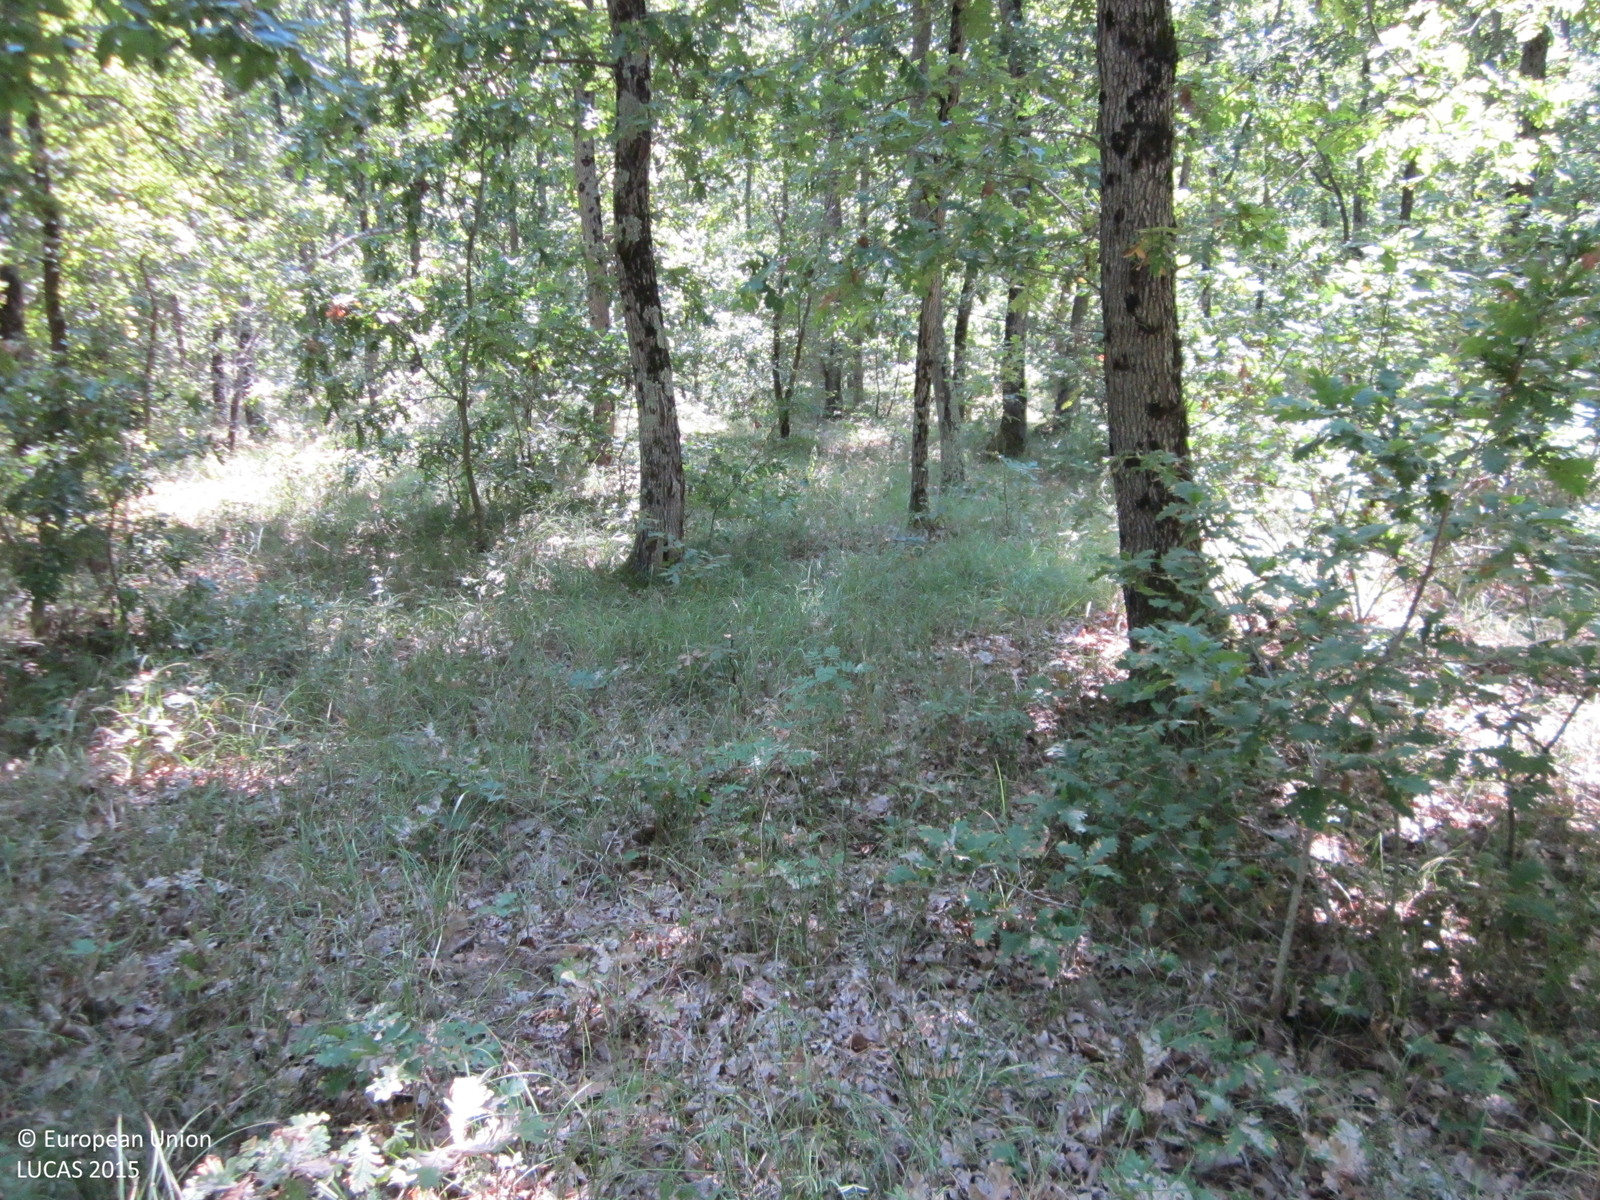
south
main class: Woodland
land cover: Broadleaved woodland
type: thermophilous deciduous forest
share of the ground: > 75 %
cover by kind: broadleaved forest trees 80 %, herbaceous plants 20 %
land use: Forestry
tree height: > 5 m
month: August
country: BG
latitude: 42.8492
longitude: 27.8136
